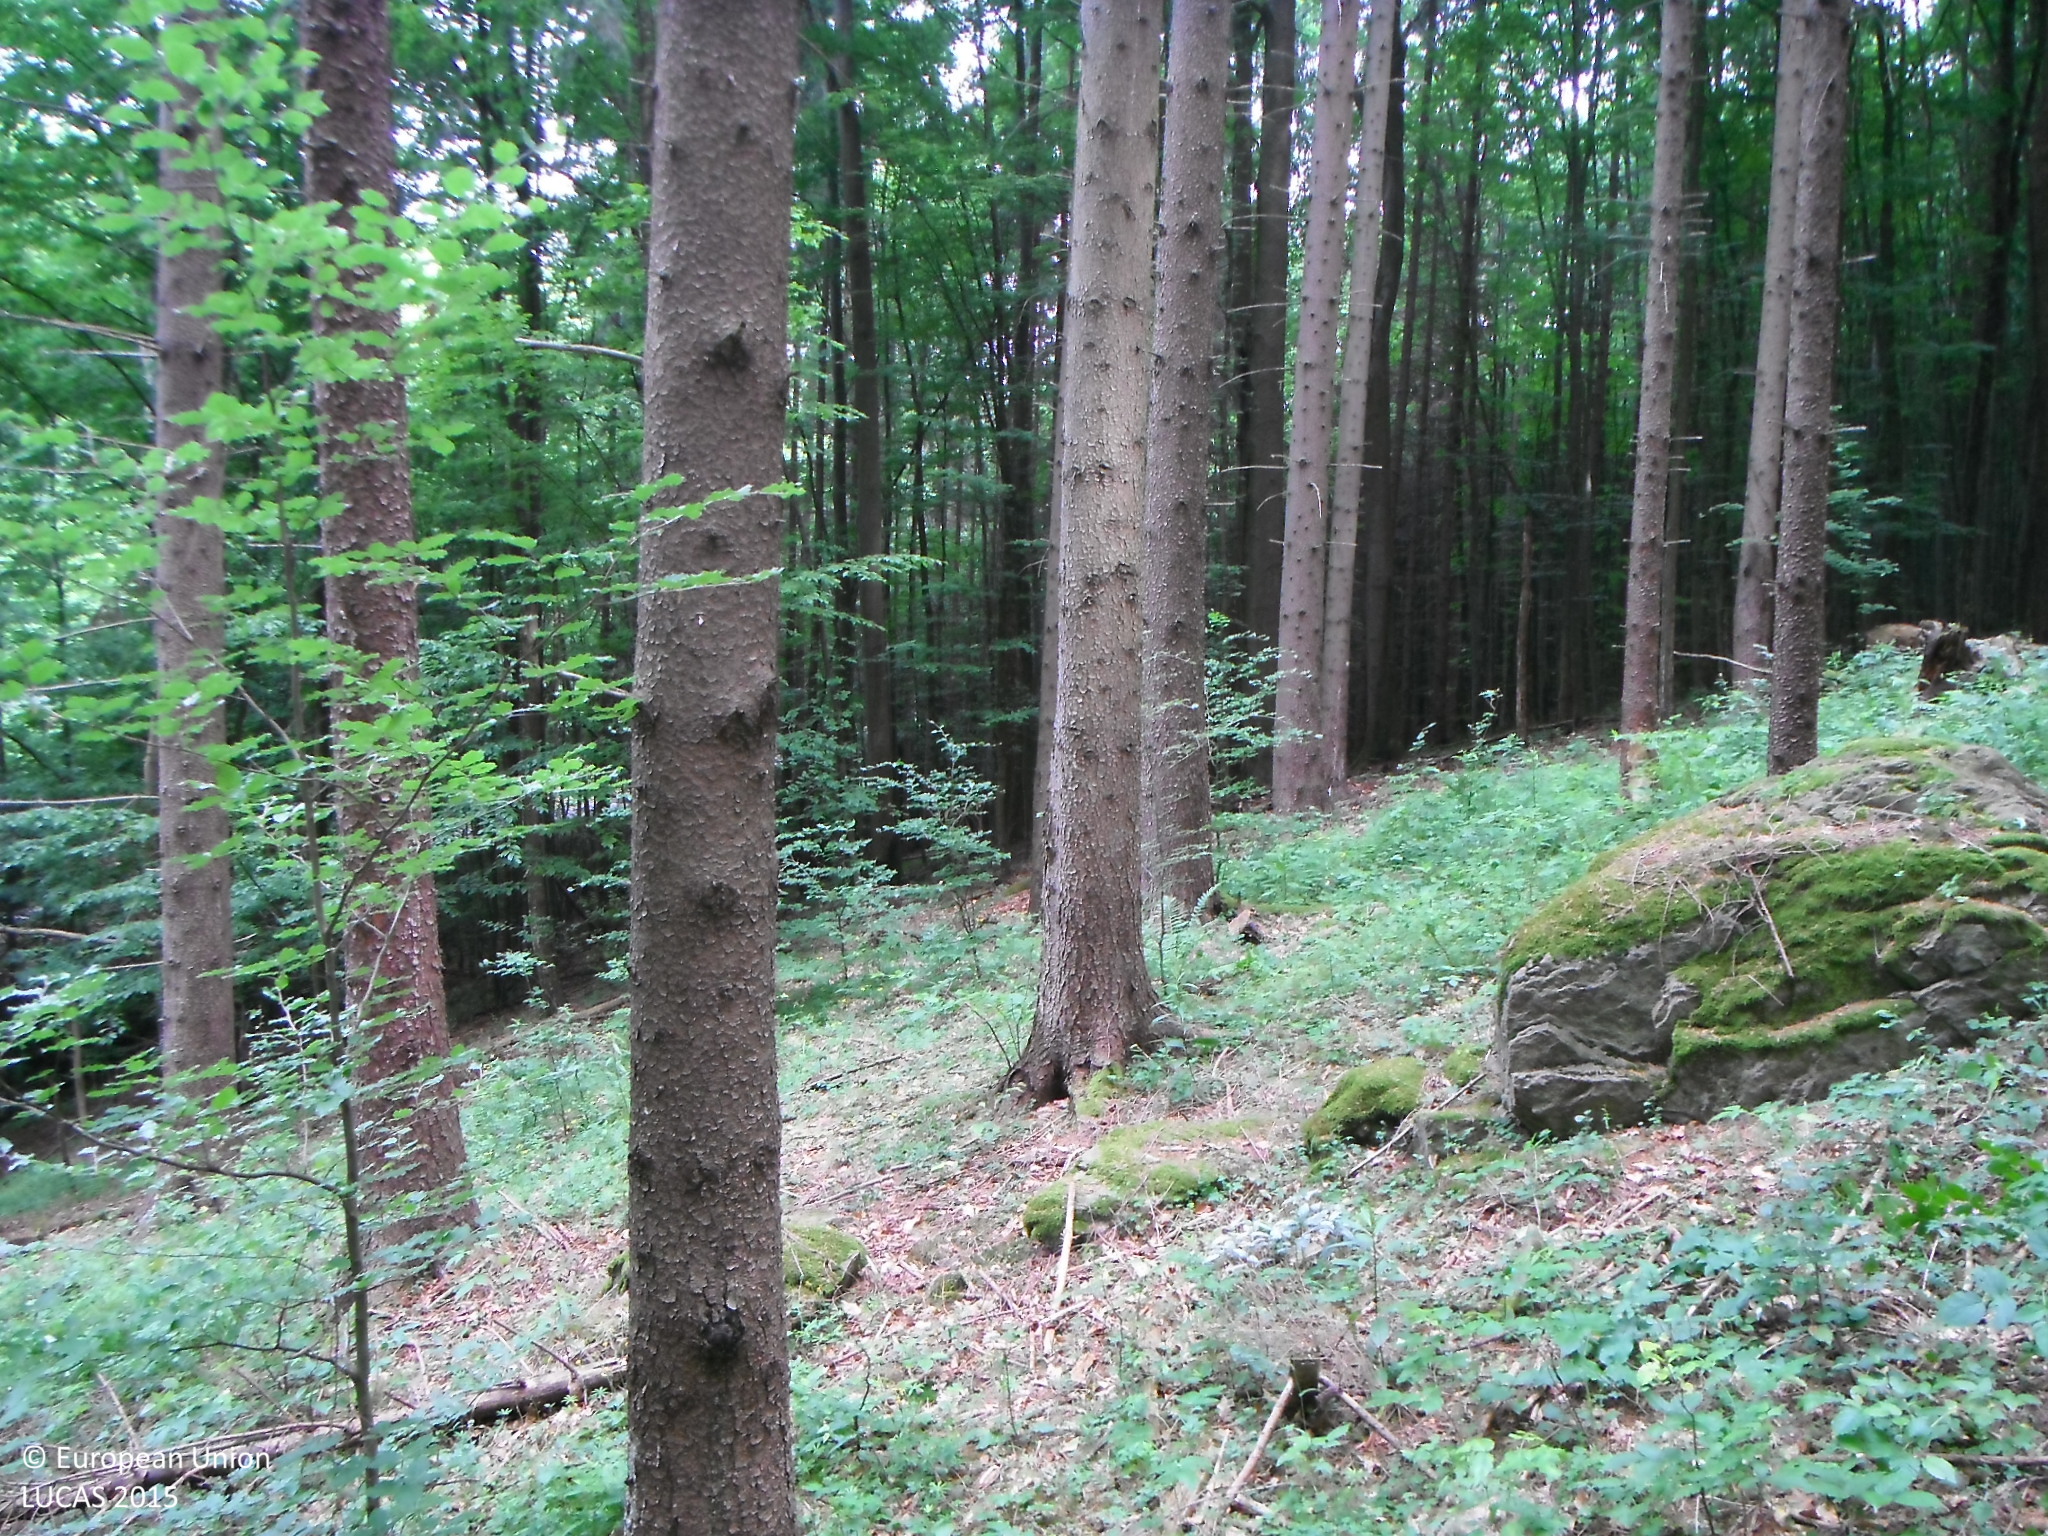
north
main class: Woodland
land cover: Spruce dominated coniferous woodland
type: alpine coniferous forest
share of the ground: > 75 %
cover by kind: coniferous forest trees 90 %, shrubs 5 %, herbaceous plants 5 %
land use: Forestry
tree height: > 5 m
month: June
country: SK
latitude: 48.6206
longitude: 19.3709
